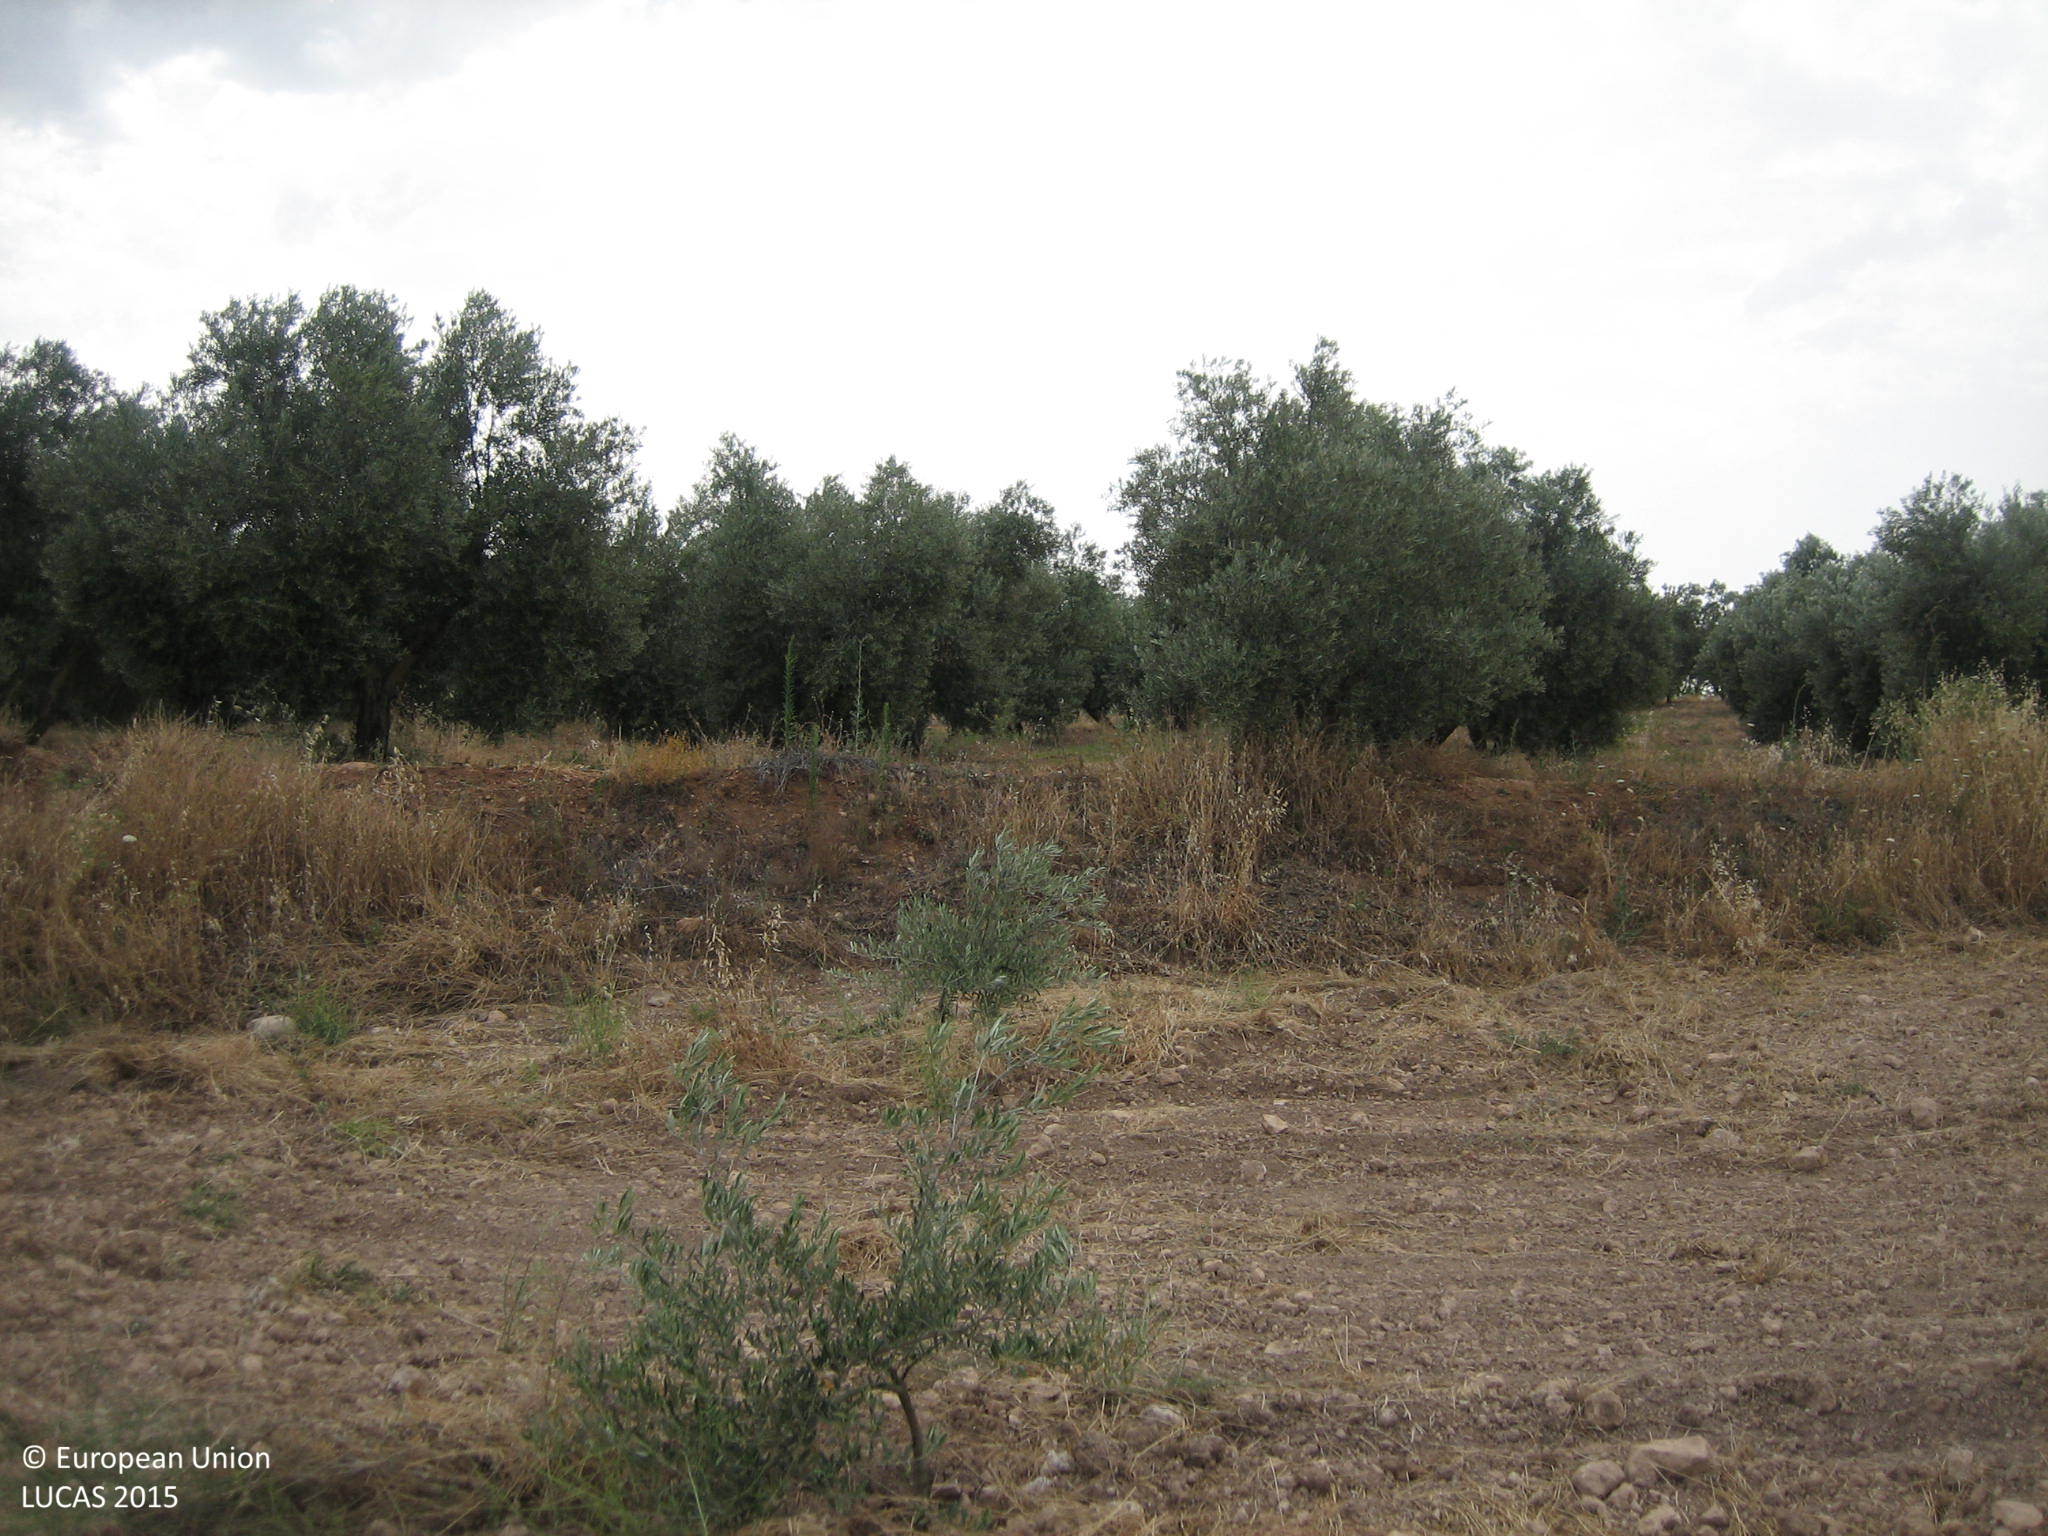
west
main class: Cropland
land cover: Olive groves
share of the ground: < 10 %
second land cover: Other bare soil
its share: > 75 %
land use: Agriculture (excluding fallow land and kitchen gardens)
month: July
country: ES
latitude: 37.6355
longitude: -2.8974
